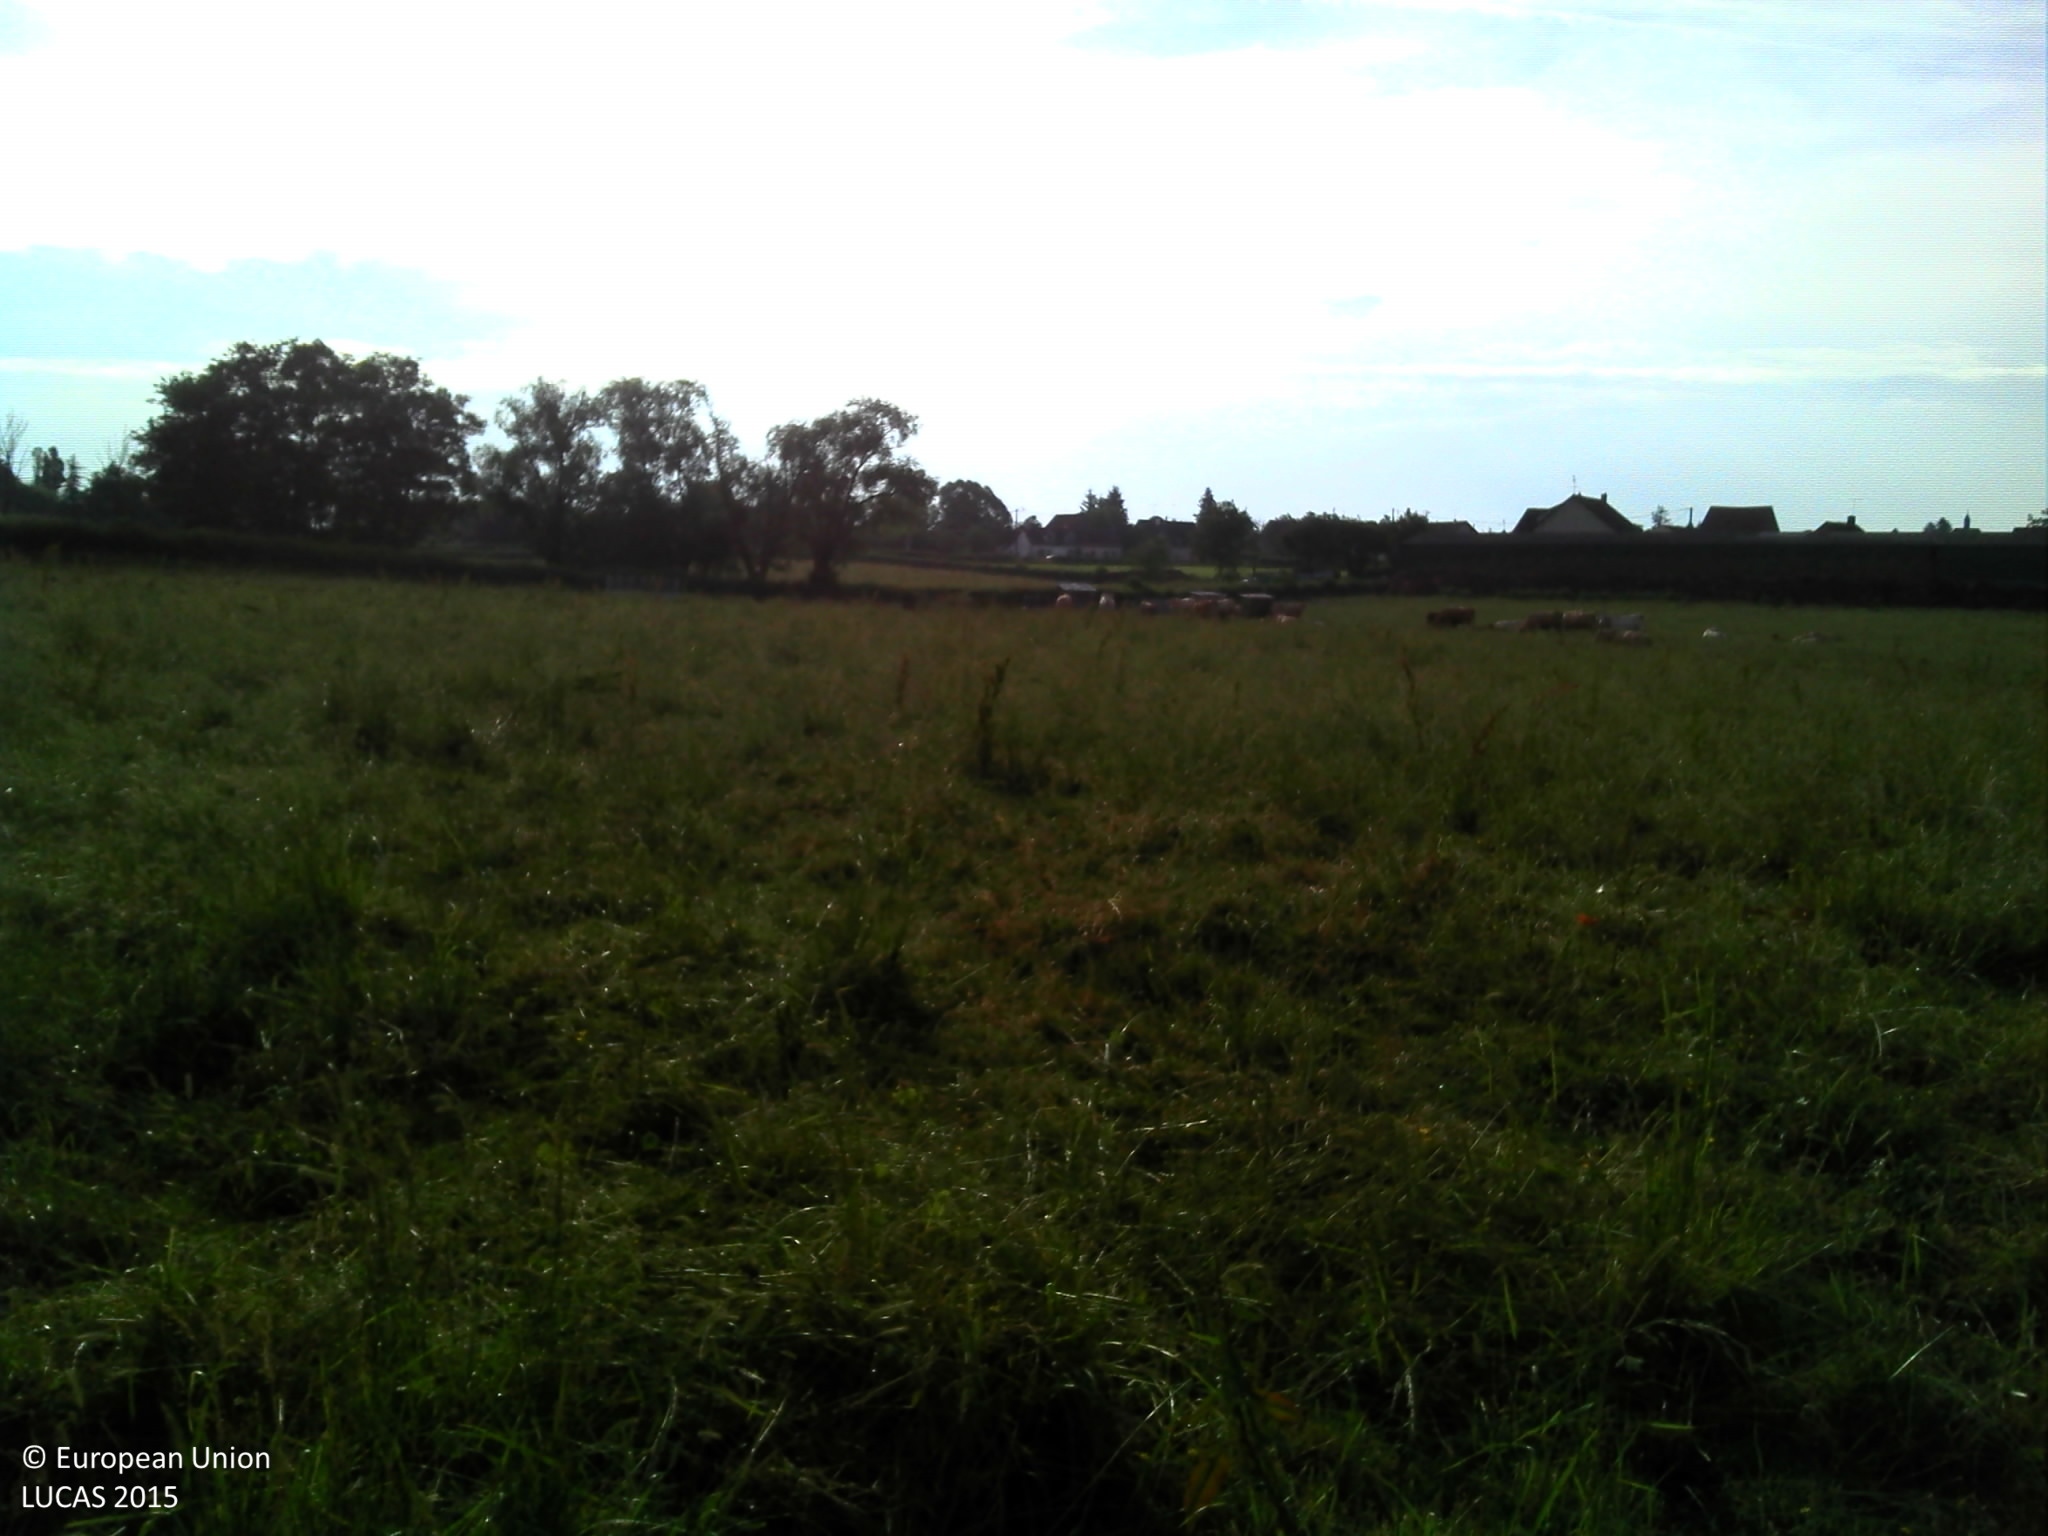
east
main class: Grassland
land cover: Grassland without tree/shrub cover
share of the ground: > 75 %
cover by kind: herbaceous plants 100 %
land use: Agriculture (excluding fallow land and kitchen gardens)
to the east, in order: Grassland without tree/shrub cover; Fences; Managed hedges; Ditches and canals; Fences; Grassland without tree/shrub cover; Managed hedges; Grass margins; Tracks; Grass margins; Abandoned hedges; Fences; Grassland without tree/shrub cover; Fences; Abandoned hedges; Fences; Grassland without tree/shrub cover
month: June
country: FR
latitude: 46.7151
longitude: 2.6824
